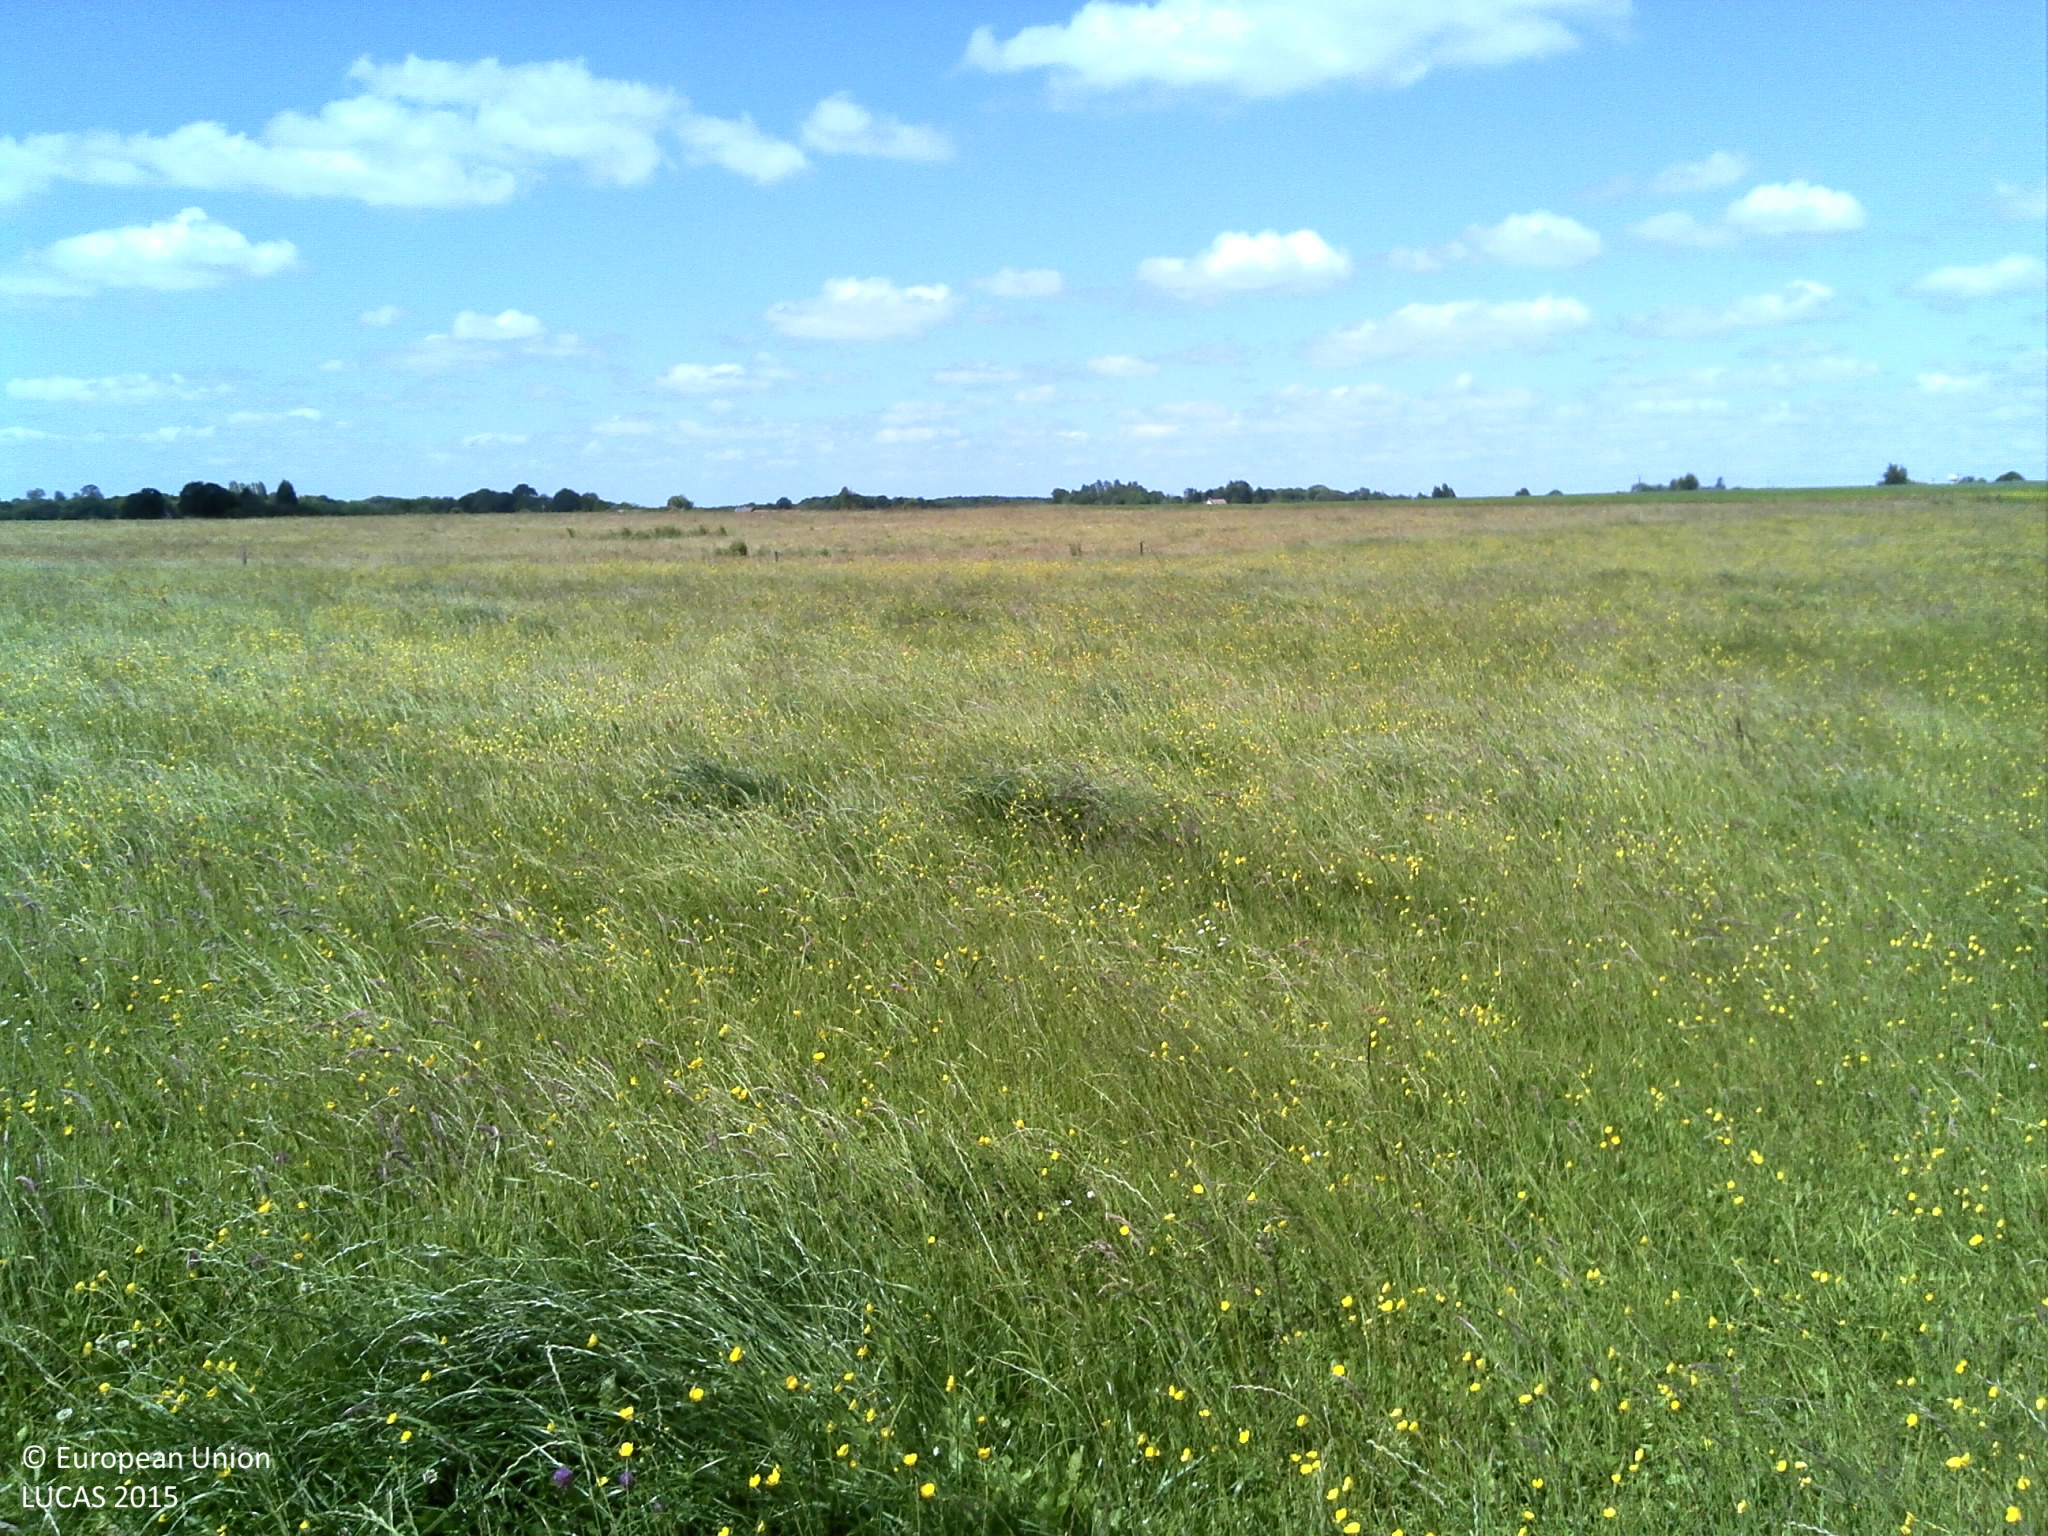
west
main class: Grassland
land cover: Grassland without tree/shrub cover
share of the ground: > 75 %
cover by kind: herbaceous plants 100 %
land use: Agriculture (excluding fallow land and kitchen gardens)
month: June
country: FR
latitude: 49.5298
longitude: 1.1223
